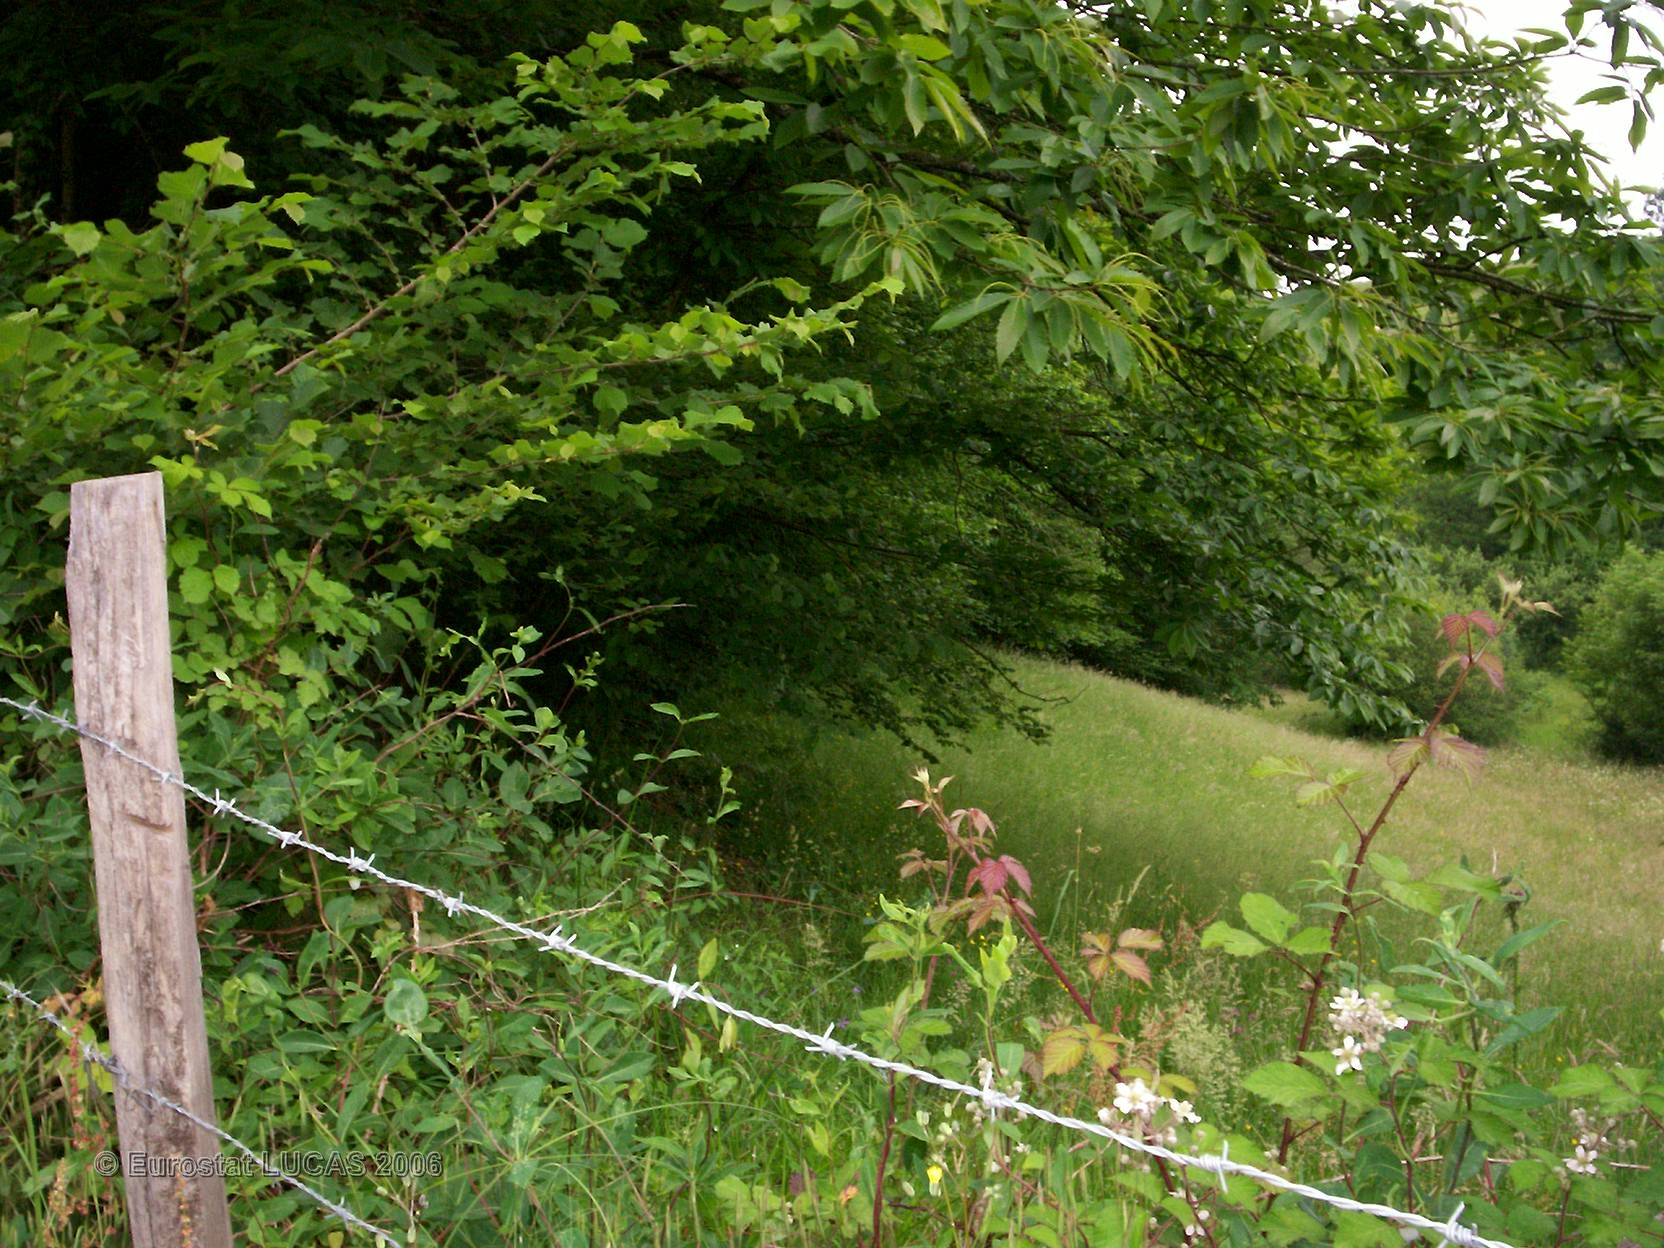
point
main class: Grassland
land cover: Grassland without tree/shrub cover
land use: Agriculture (excluding fallow land and kitchen gardens)
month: May
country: FR
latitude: 43.1526
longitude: -1.2655
